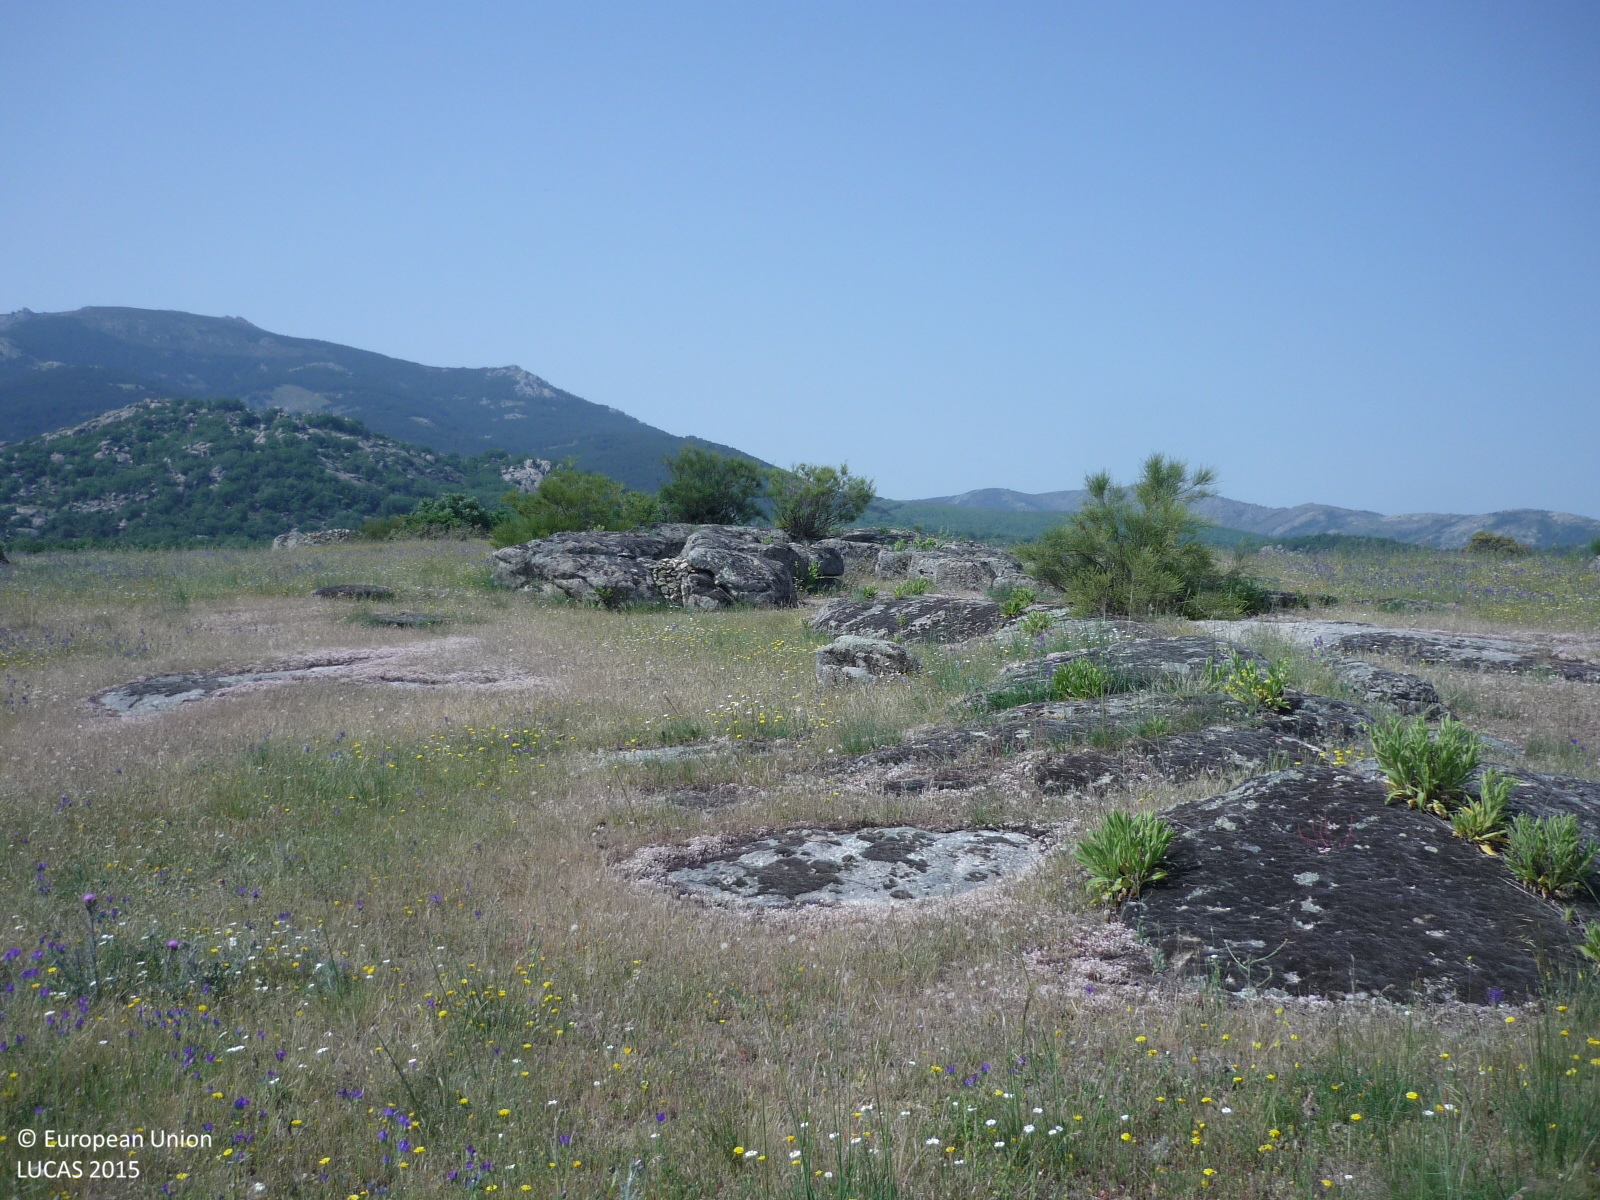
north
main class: Grassland
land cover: Grassland with sparse tree/shrub cover
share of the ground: > 75 %
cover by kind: herbaceous plants 85 %, shrubs 10 %, broadleaved forest trees 5 %
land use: Agriculture (excluding fallow land and kitchen gardens)
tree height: < 5 m
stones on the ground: < 10 %
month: May
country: ES
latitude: 40.7711
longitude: -3.7984
